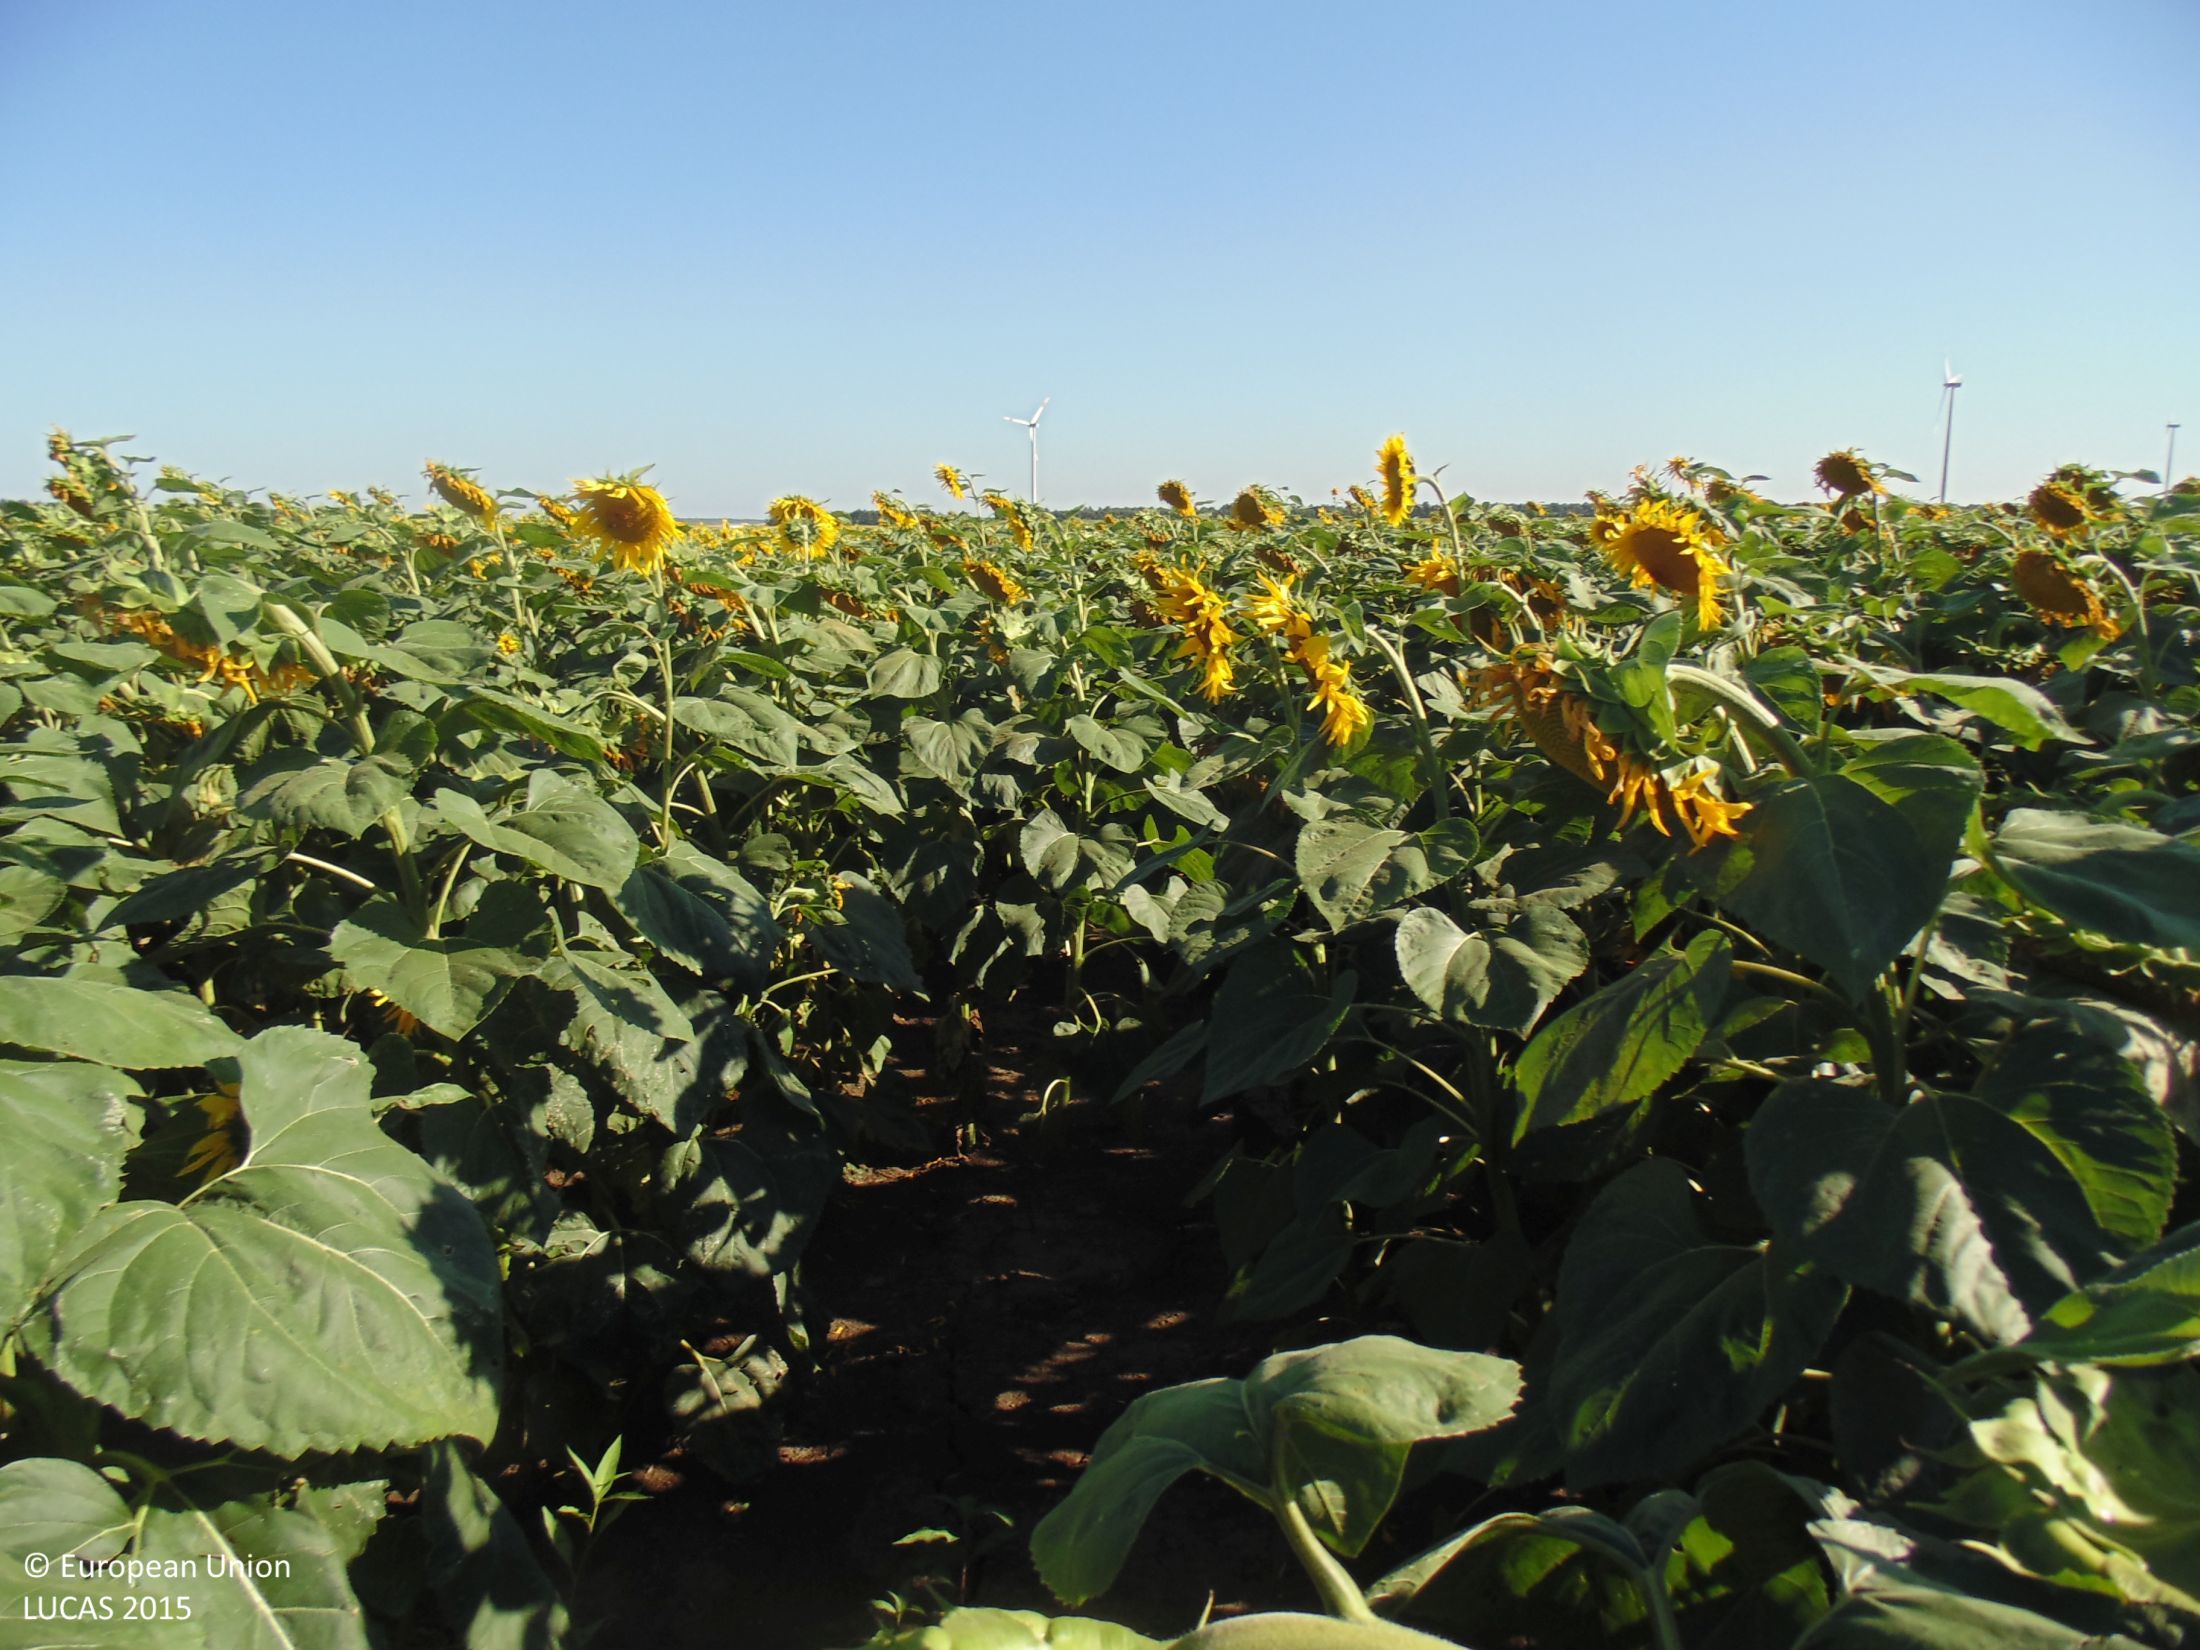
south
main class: Cropland
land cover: Sunflower
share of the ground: > 75 %
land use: Agriculture (excluding fallow land and kitchen gardens)
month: July
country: BG
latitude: 43.4520
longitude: 28.0528
